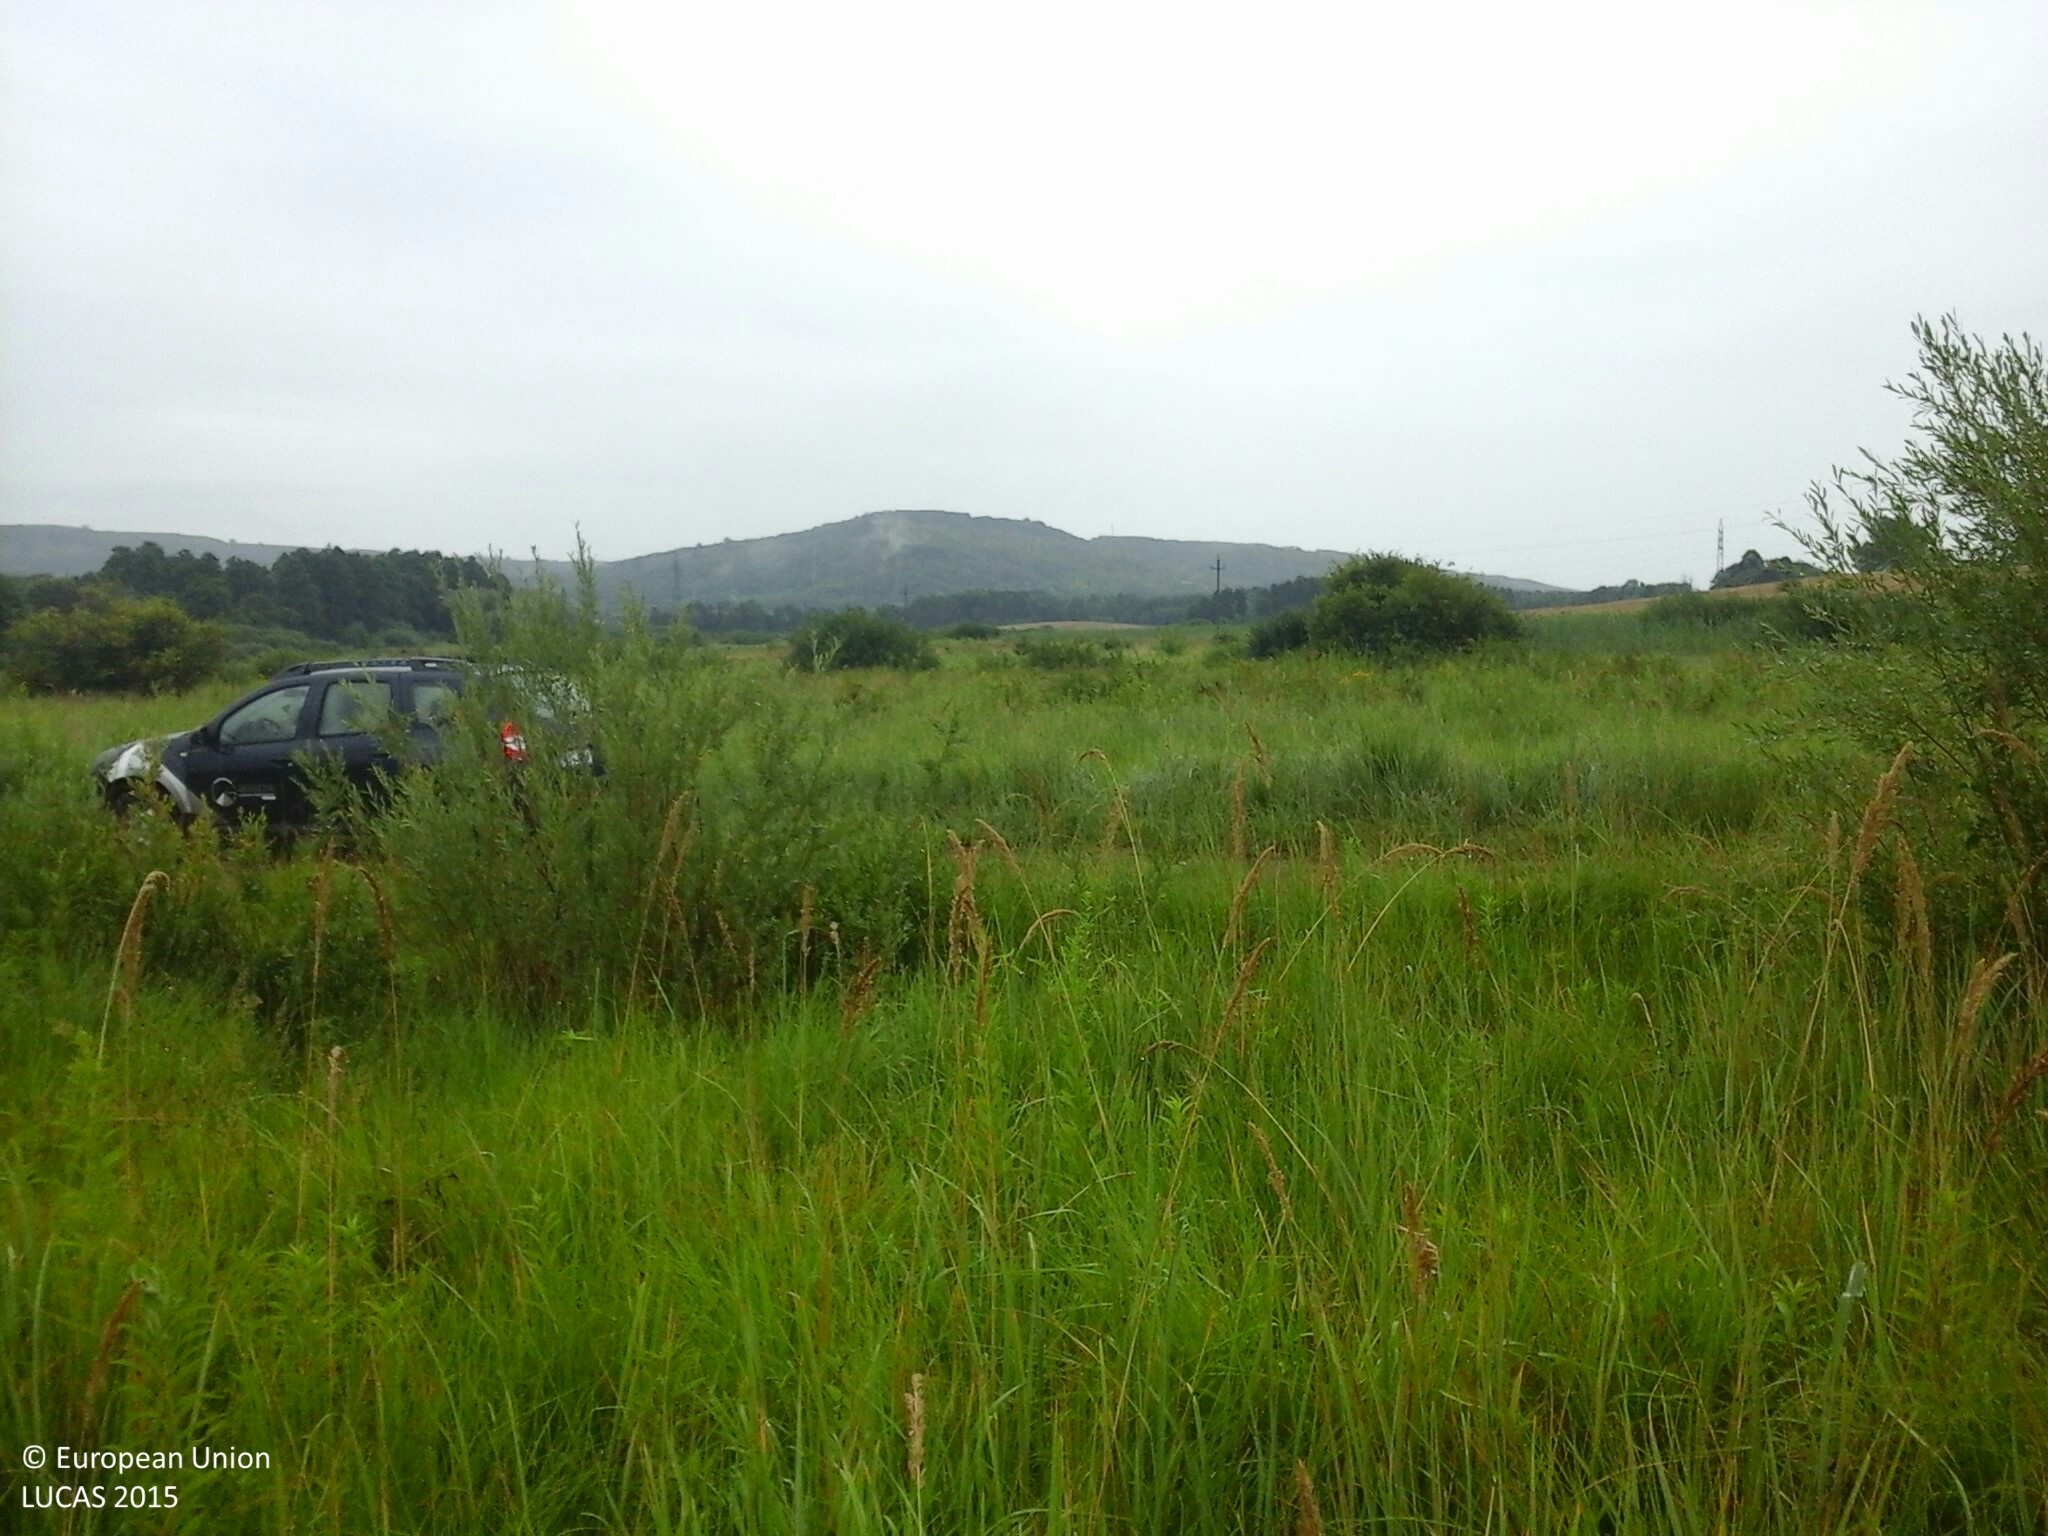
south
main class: Grassland
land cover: Spontaneously vegetated surfaces
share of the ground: > 75 %
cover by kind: herbaceous plants 100 %
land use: Semi-natural and natural areas not in use
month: July
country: HU
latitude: 46.7378
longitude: 17.7678
